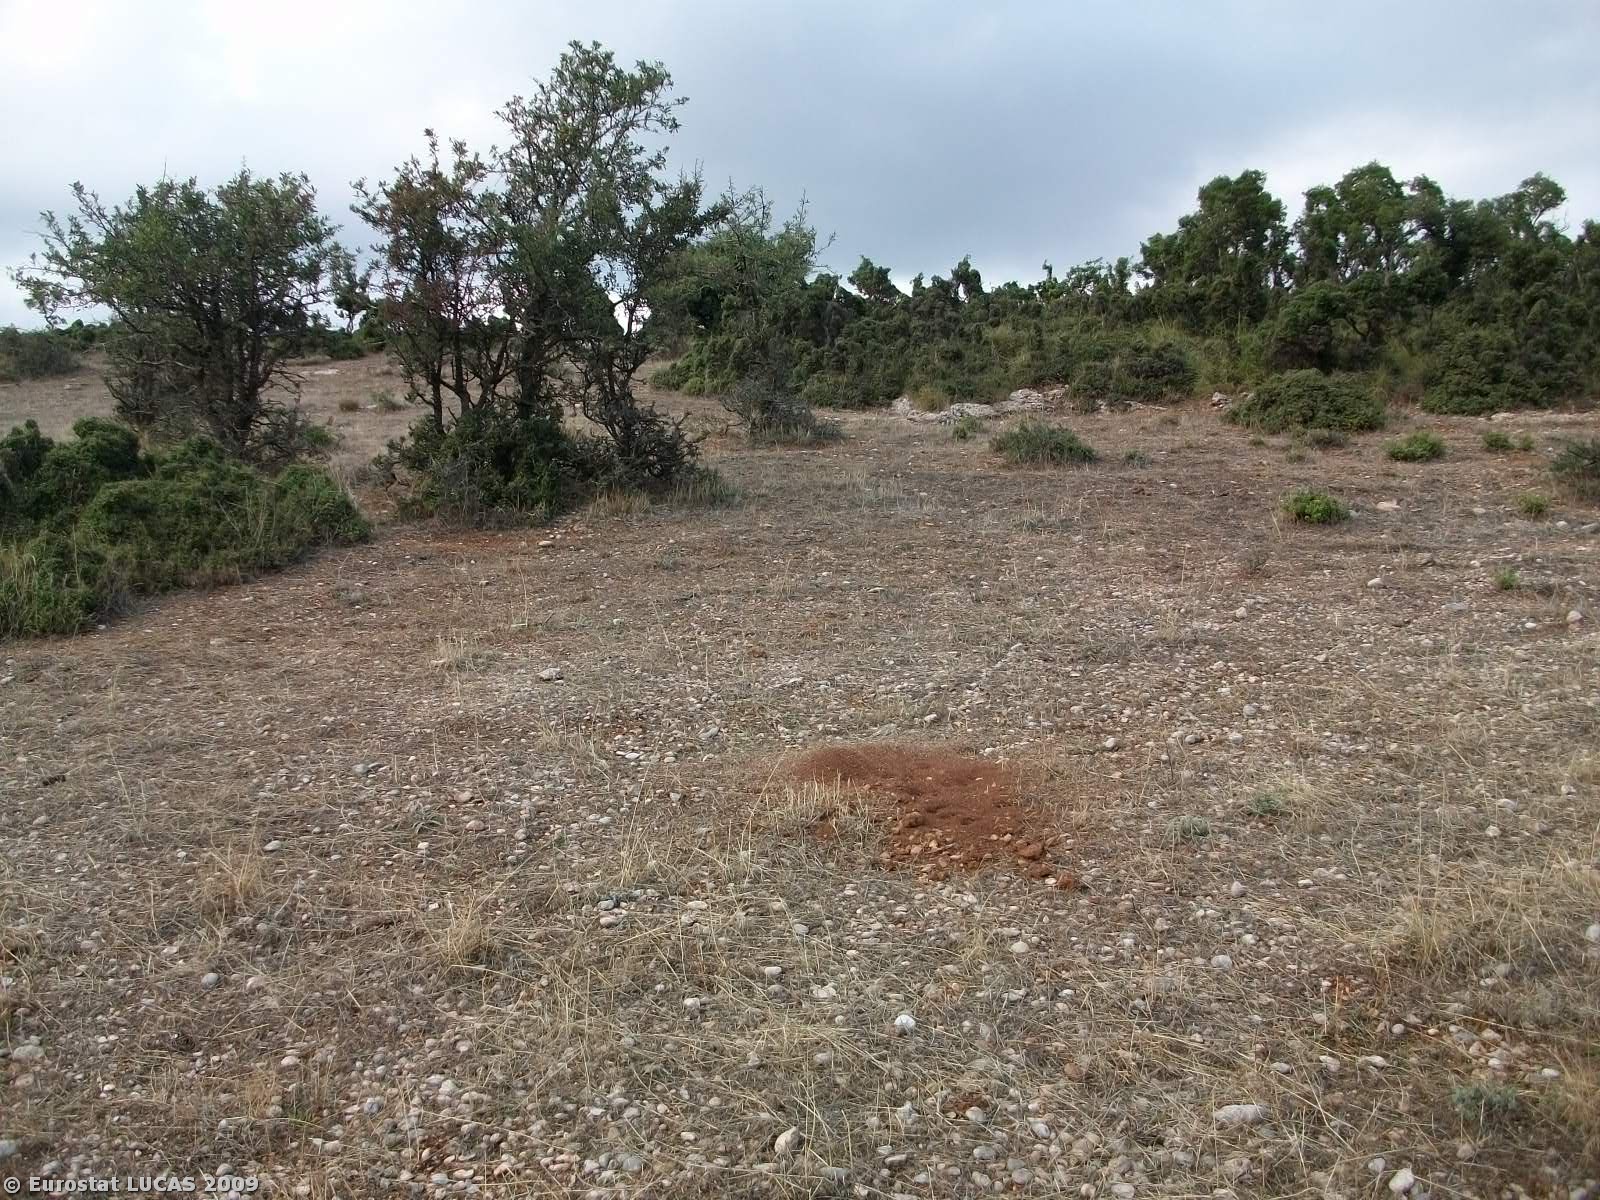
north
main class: Grassland
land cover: Grassland with sparse tree/shrub cover
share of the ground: > 75 %
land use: Agriculture (excluding fallow land and kitchen gardens)
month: September
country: GR
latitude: 37.8504
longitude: 22.5258
